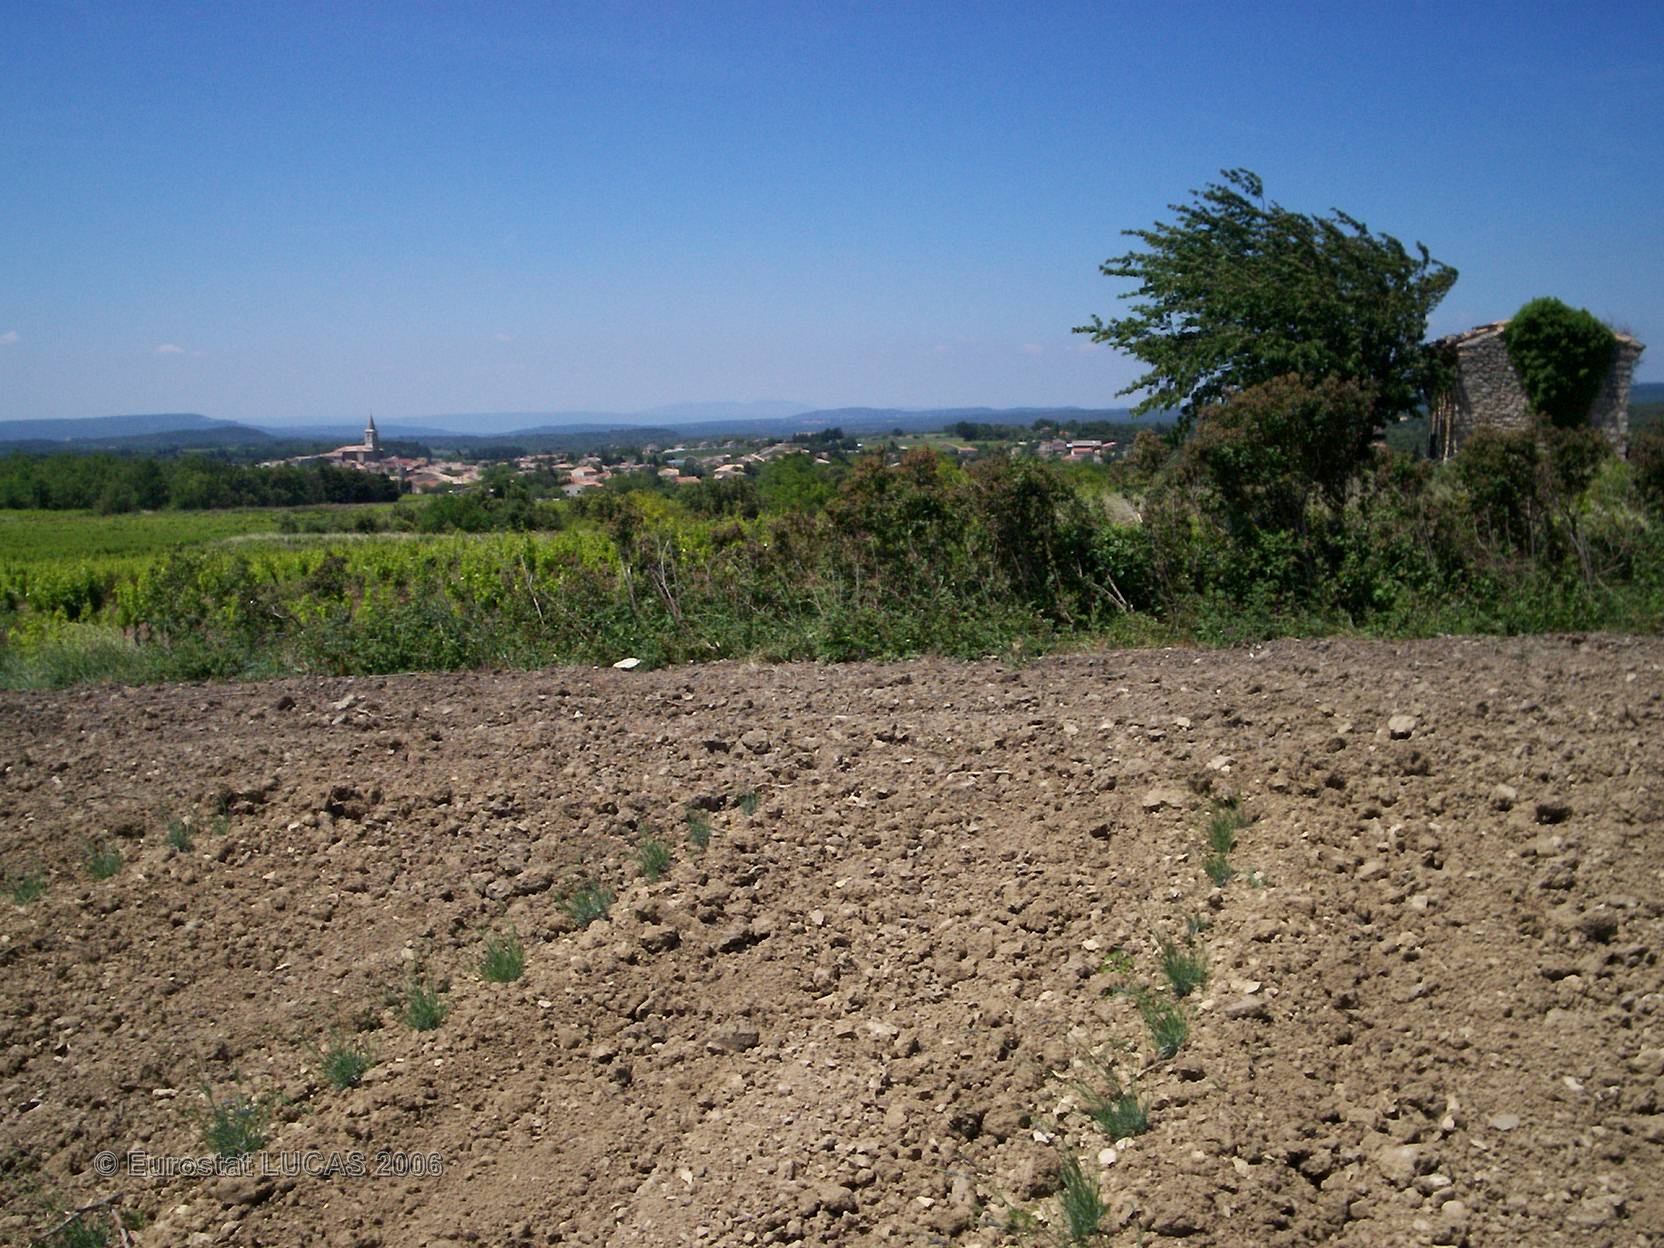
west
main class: Cropland
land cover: Permanent industrial crops
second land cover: Bare land
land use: Agriculture (excluding fallow land and kitchen gardens)
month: June
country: FR
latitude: 44.4465
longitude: 4.9935
